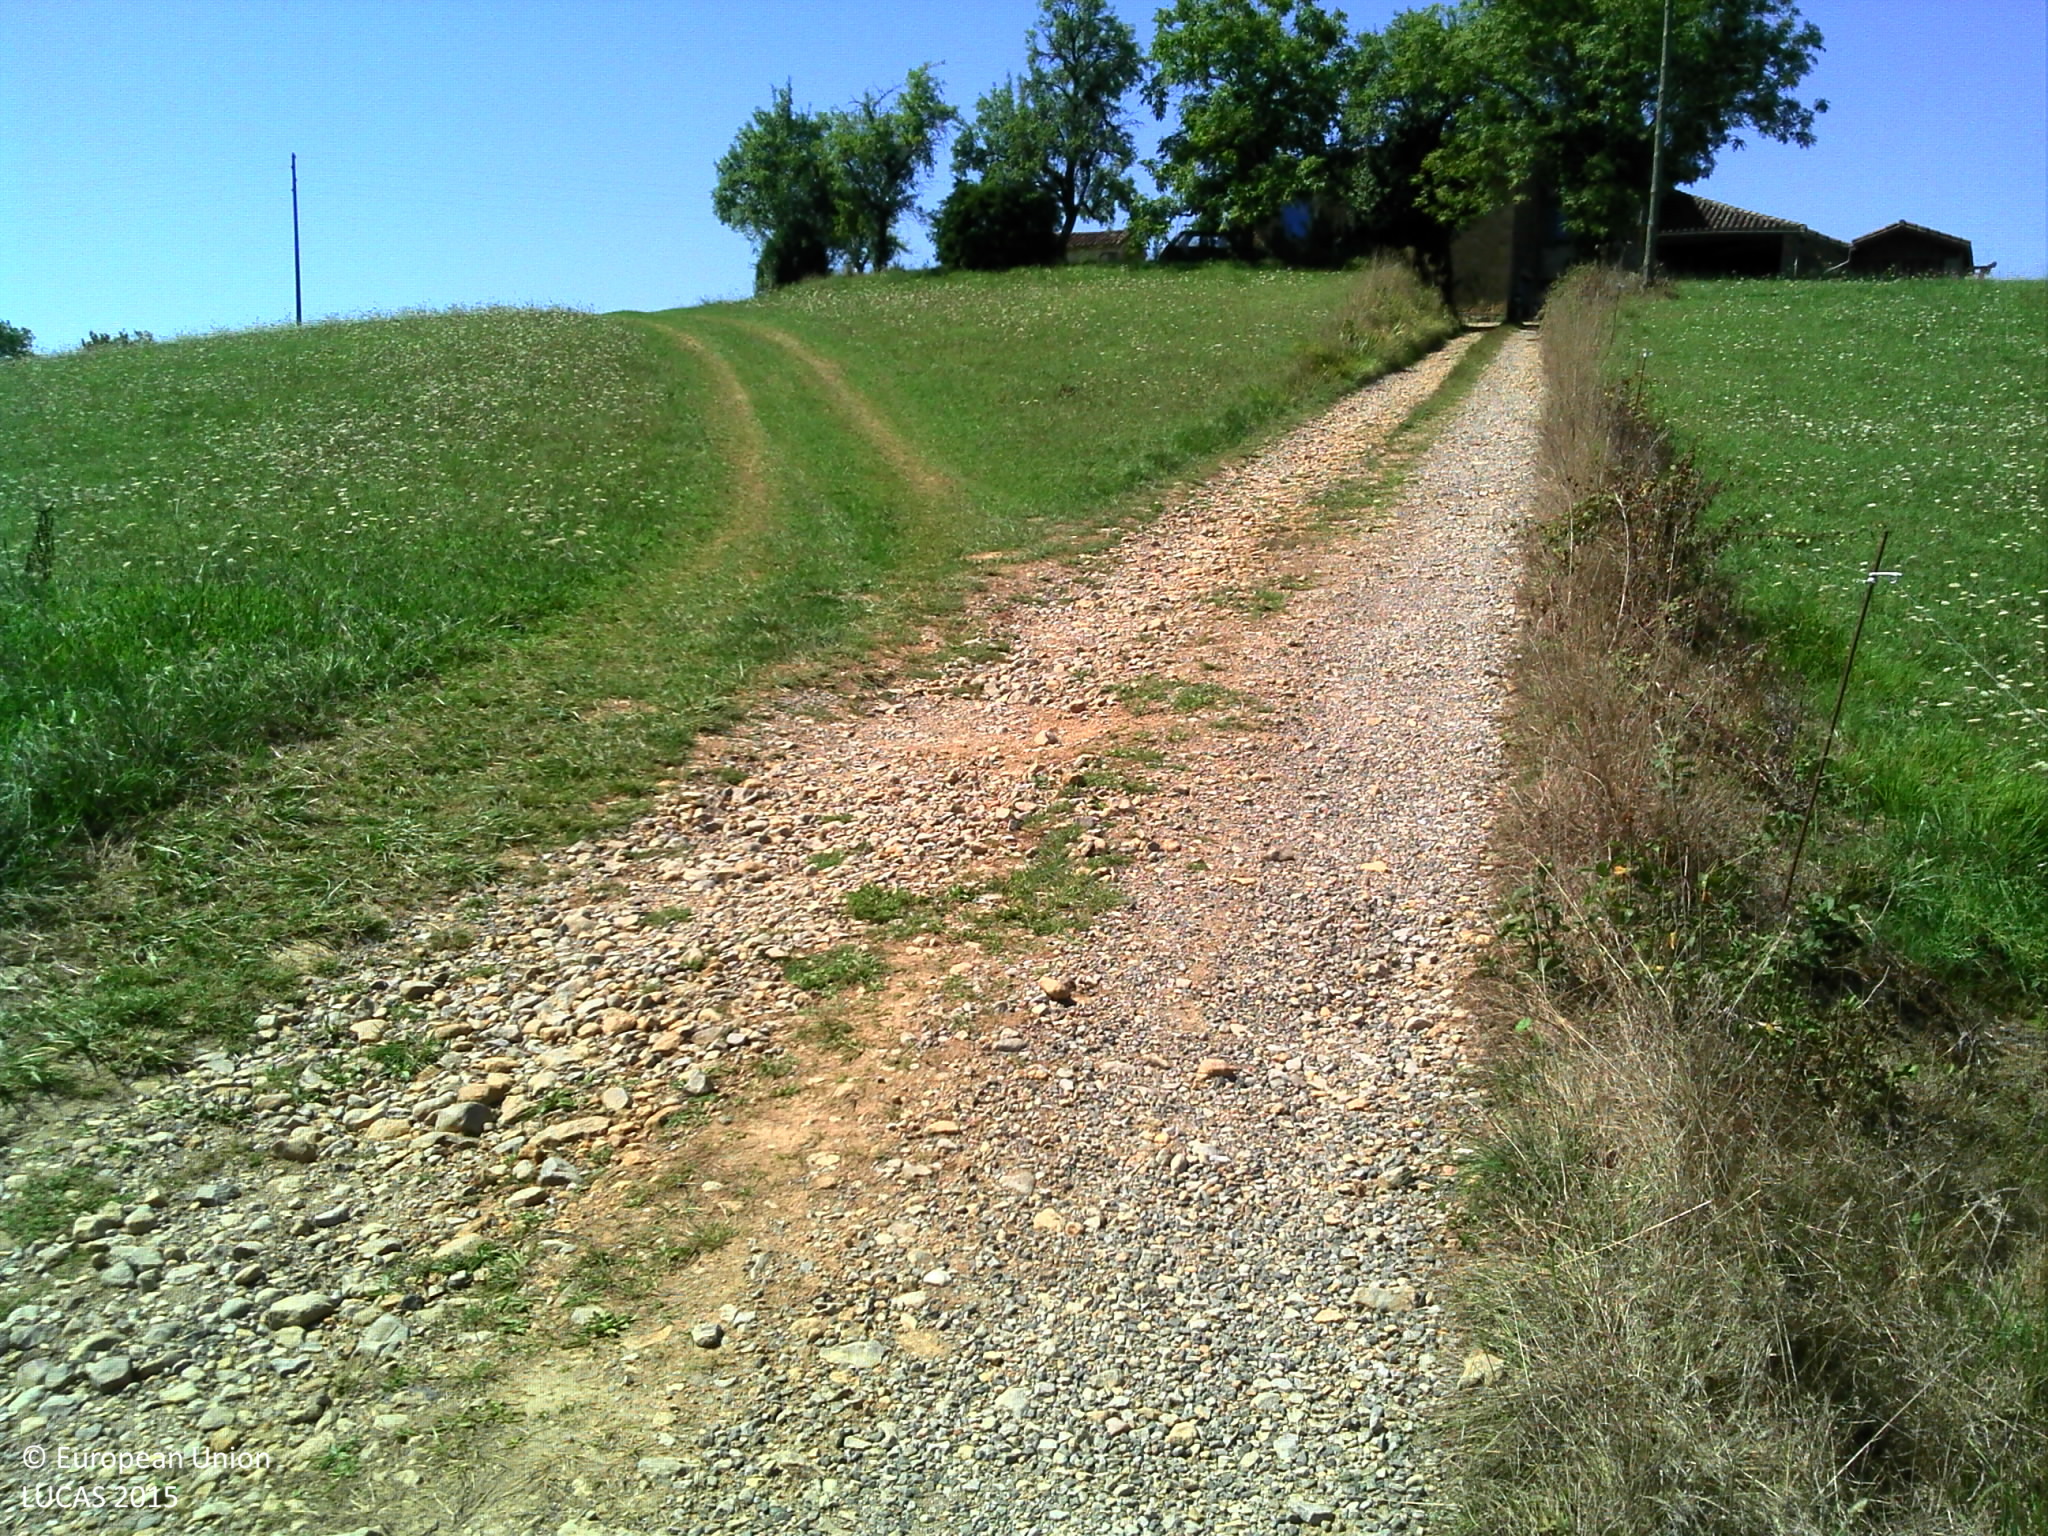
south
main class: Grassland
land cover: Grassland without tree/shrub cover
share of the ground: > 75 %
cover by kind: herbaceous plants 100 %
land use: Agriculture (excluding fallow land and kitchen gardens)
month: August
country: FR
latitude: 44.1792
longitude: 1.9086
